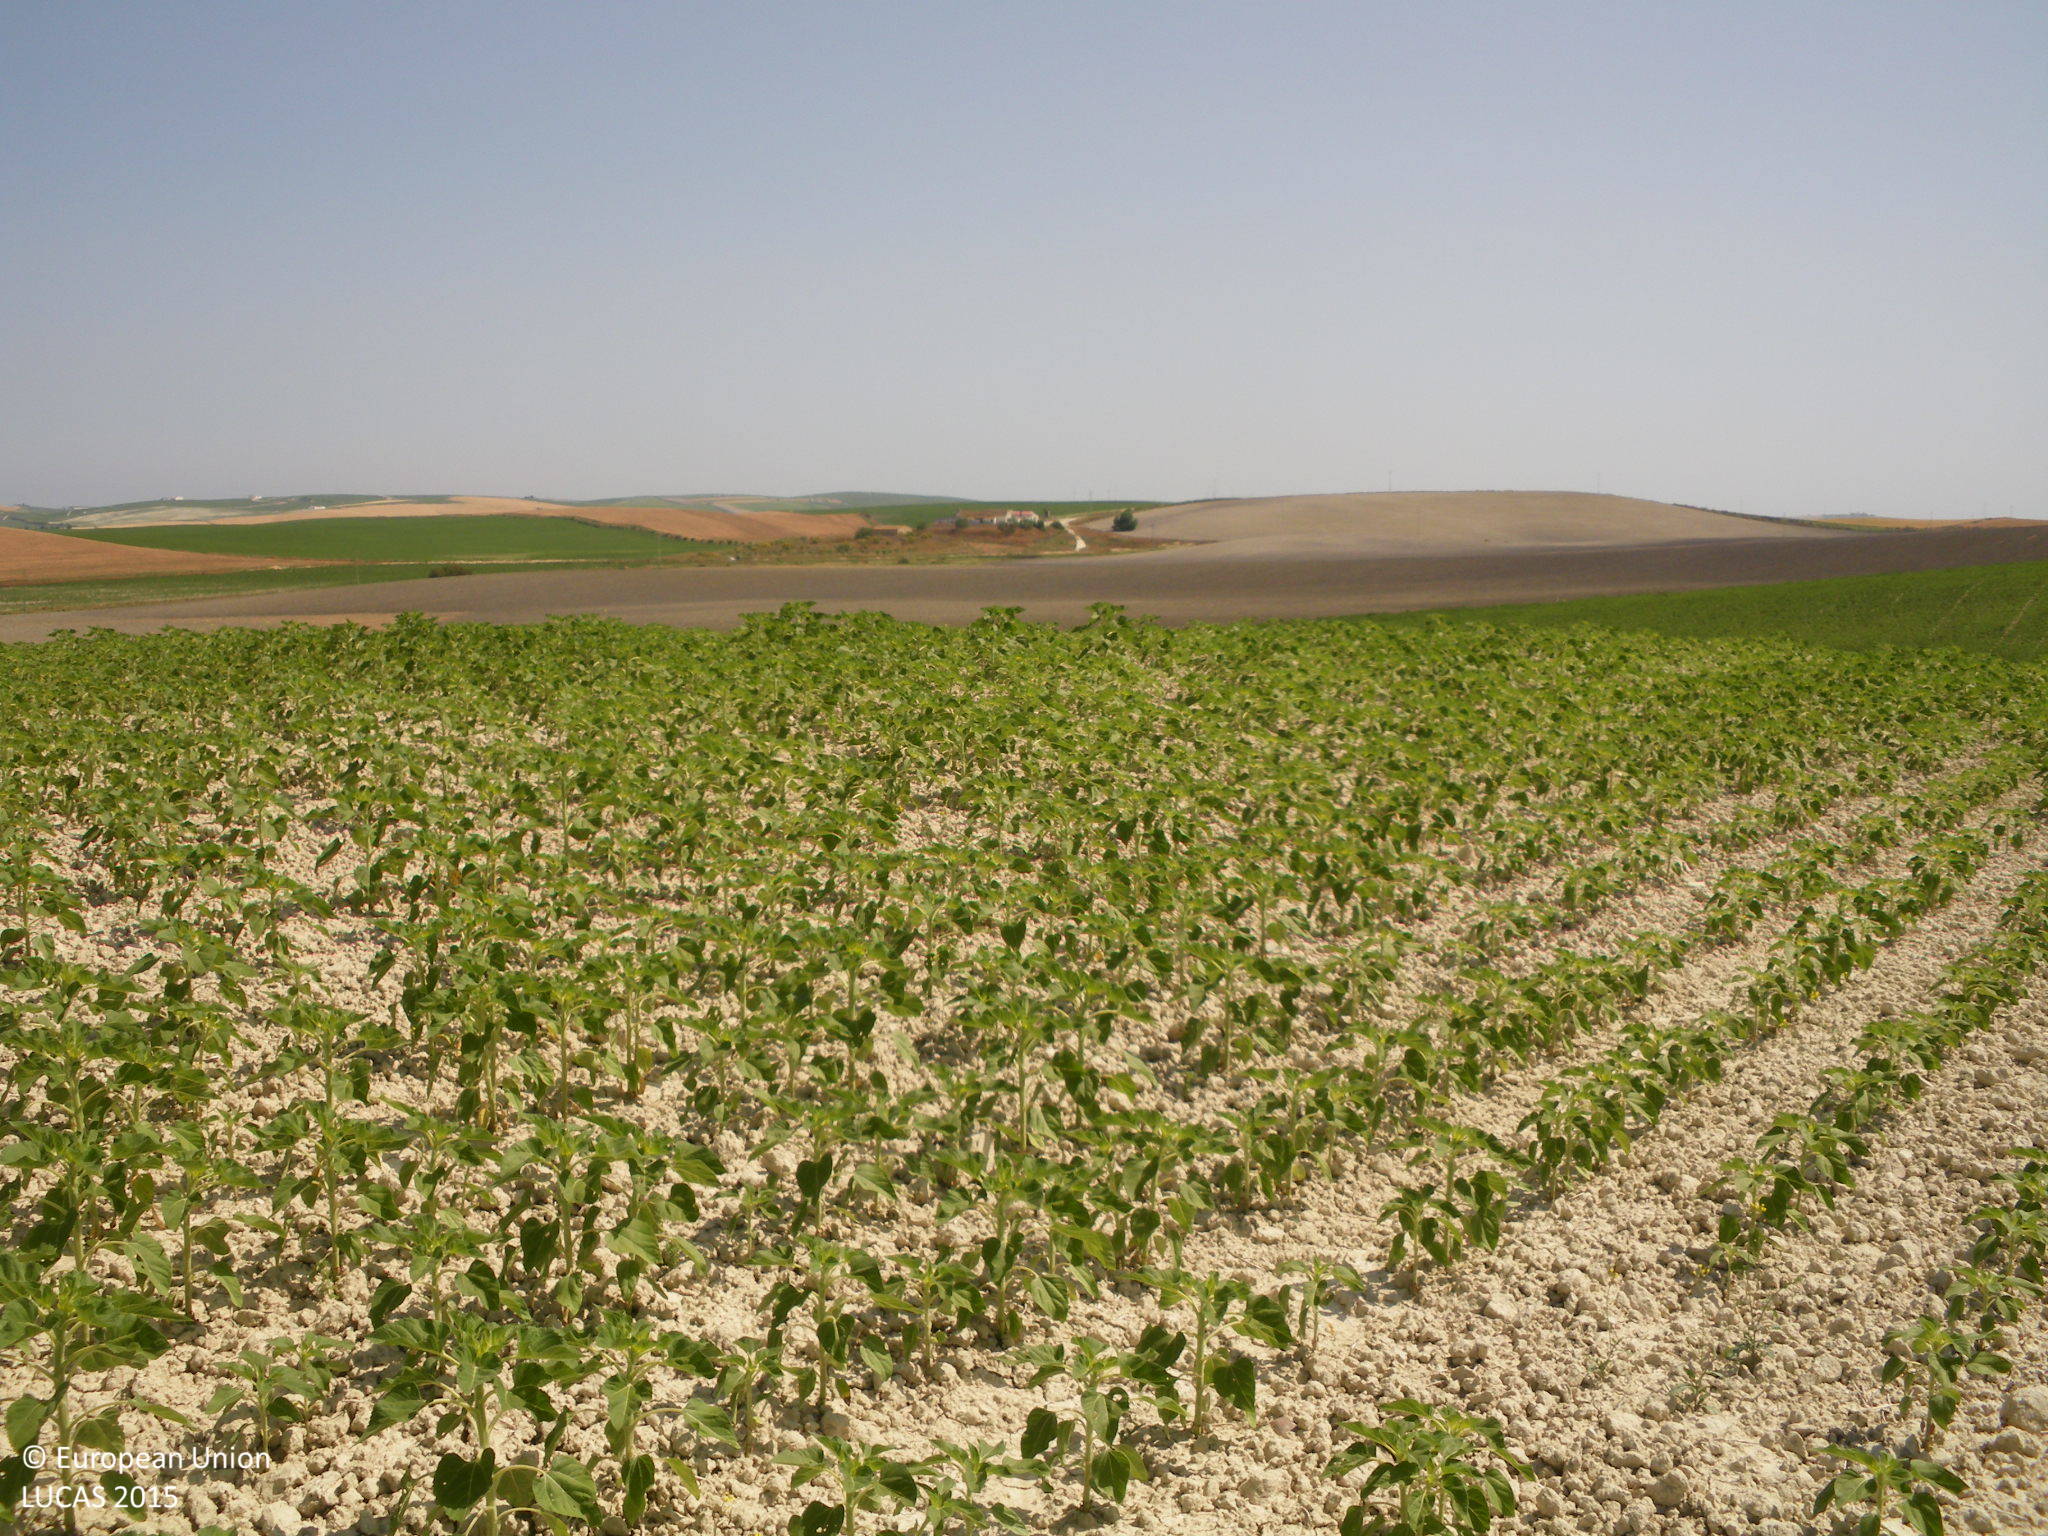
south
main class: Cropland
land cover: Sunflower
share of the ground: 10 - 25 %
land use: Agriculture (excluding fallow land and kitchen gardens)
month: May
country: ES
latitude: 36.7898
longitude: -6.2085
